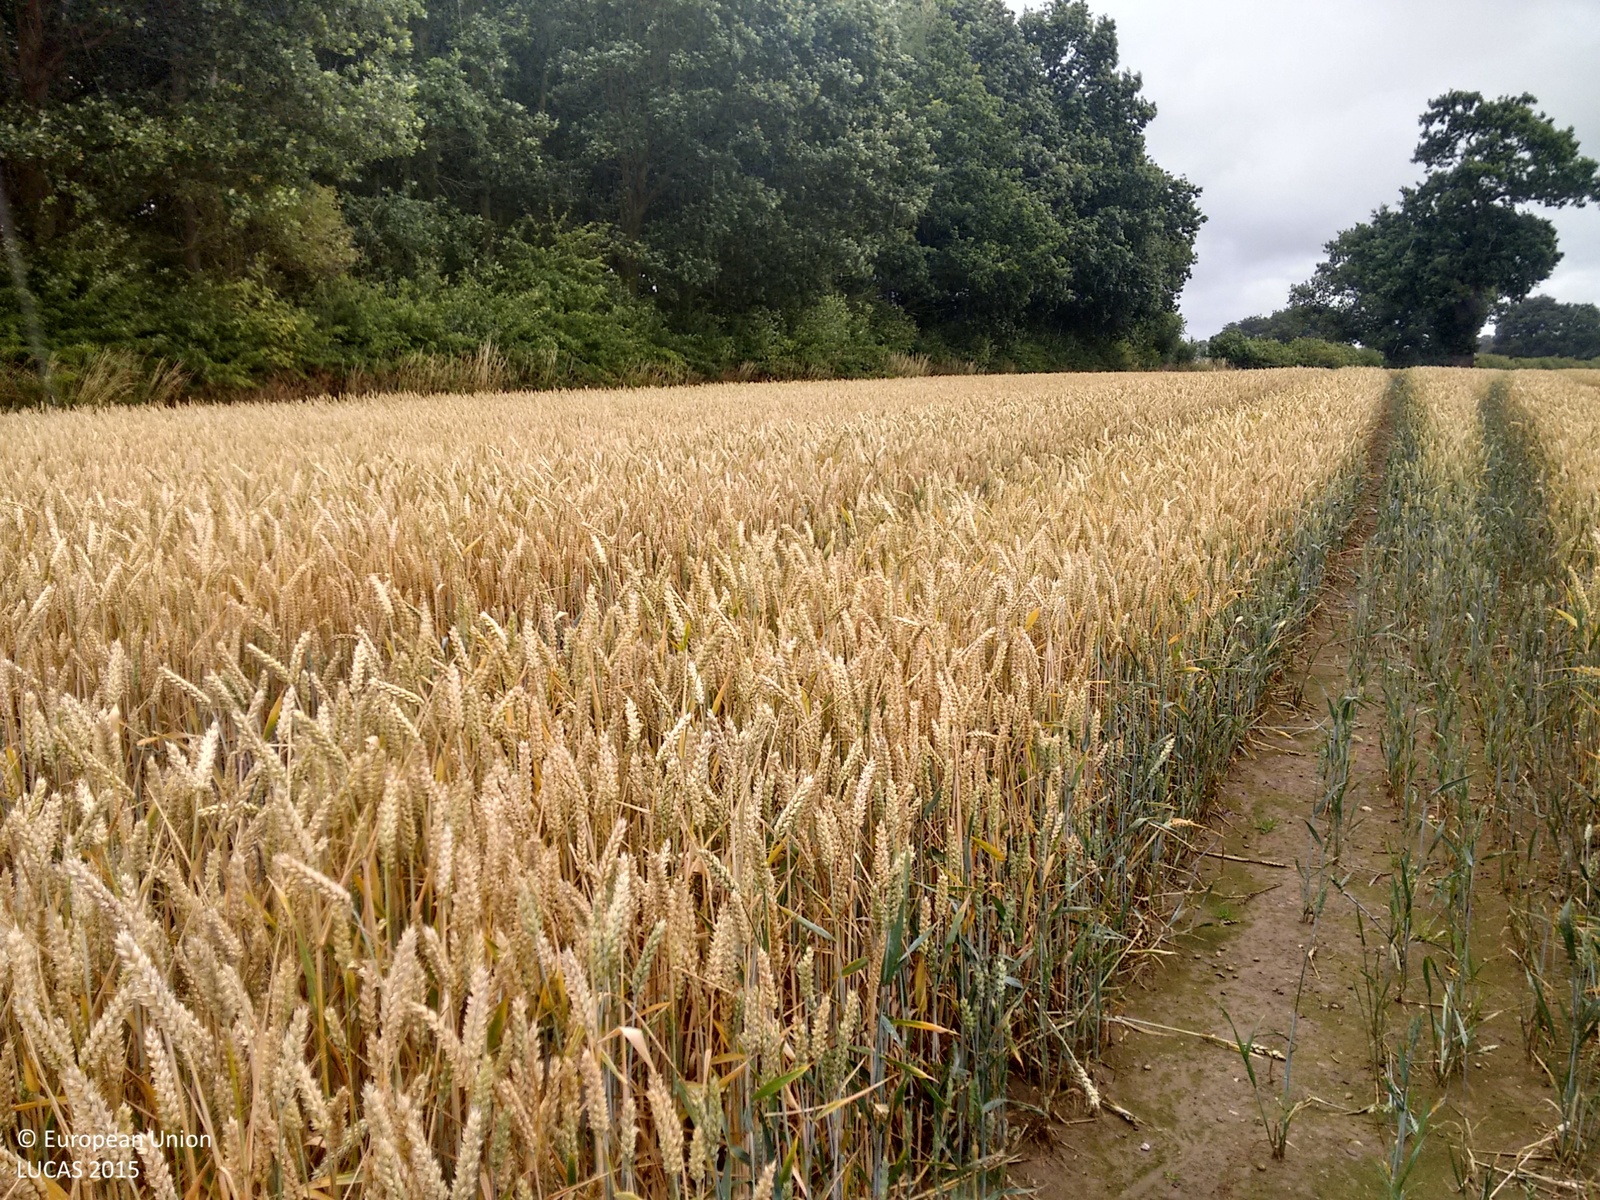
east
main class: Cropland
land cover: Common wheat
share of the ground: > 75 %
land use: Agriculture (excluding fallow land and kitchen gardens)
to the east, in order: Common wheat; Grass margins; Broadleaved woodland; Grass margins; Common wheat
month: July
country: GB
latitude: 52.6491
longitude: -2.2565
